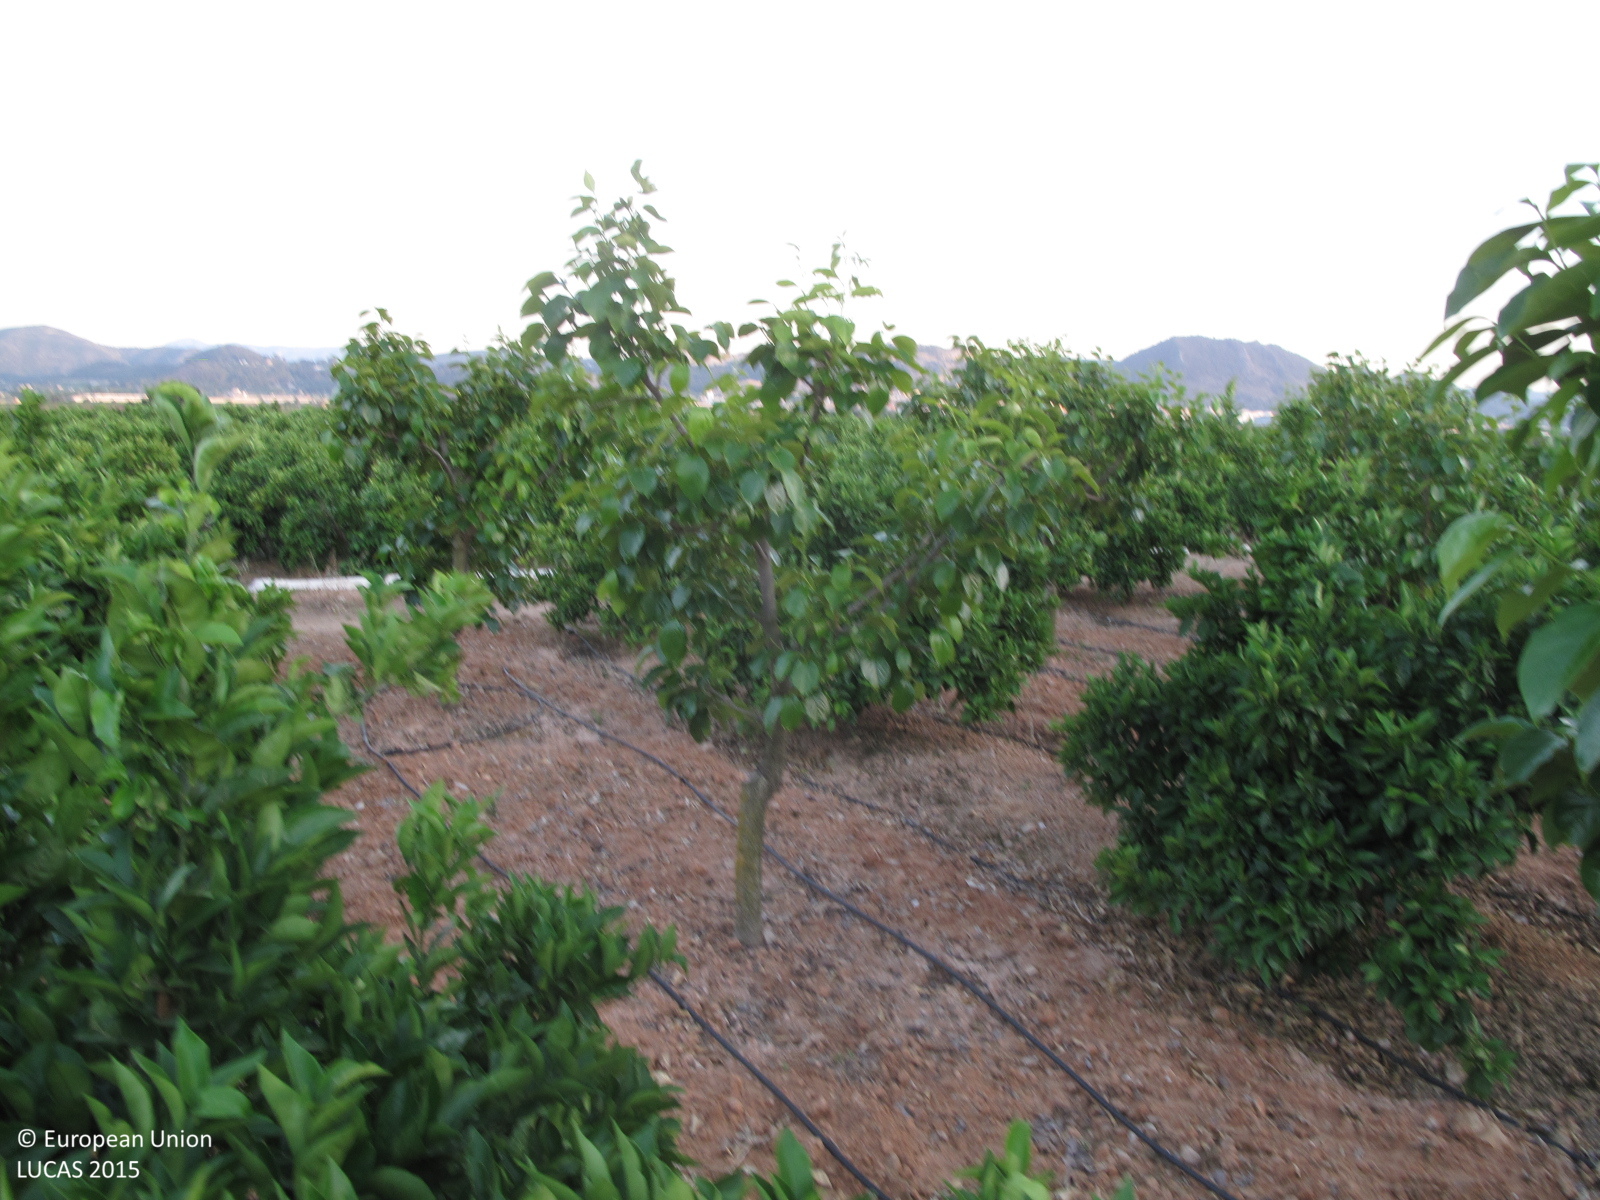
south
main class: Cropland
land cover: Oranges
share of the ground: 25 - 50 %
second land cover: Other fruit trees and berries
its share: 25 - 50 %
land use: Agriculture (excluding fallow land and kitchen gardens)
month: May
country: ES
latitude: 39.0257
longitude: -0.5159
